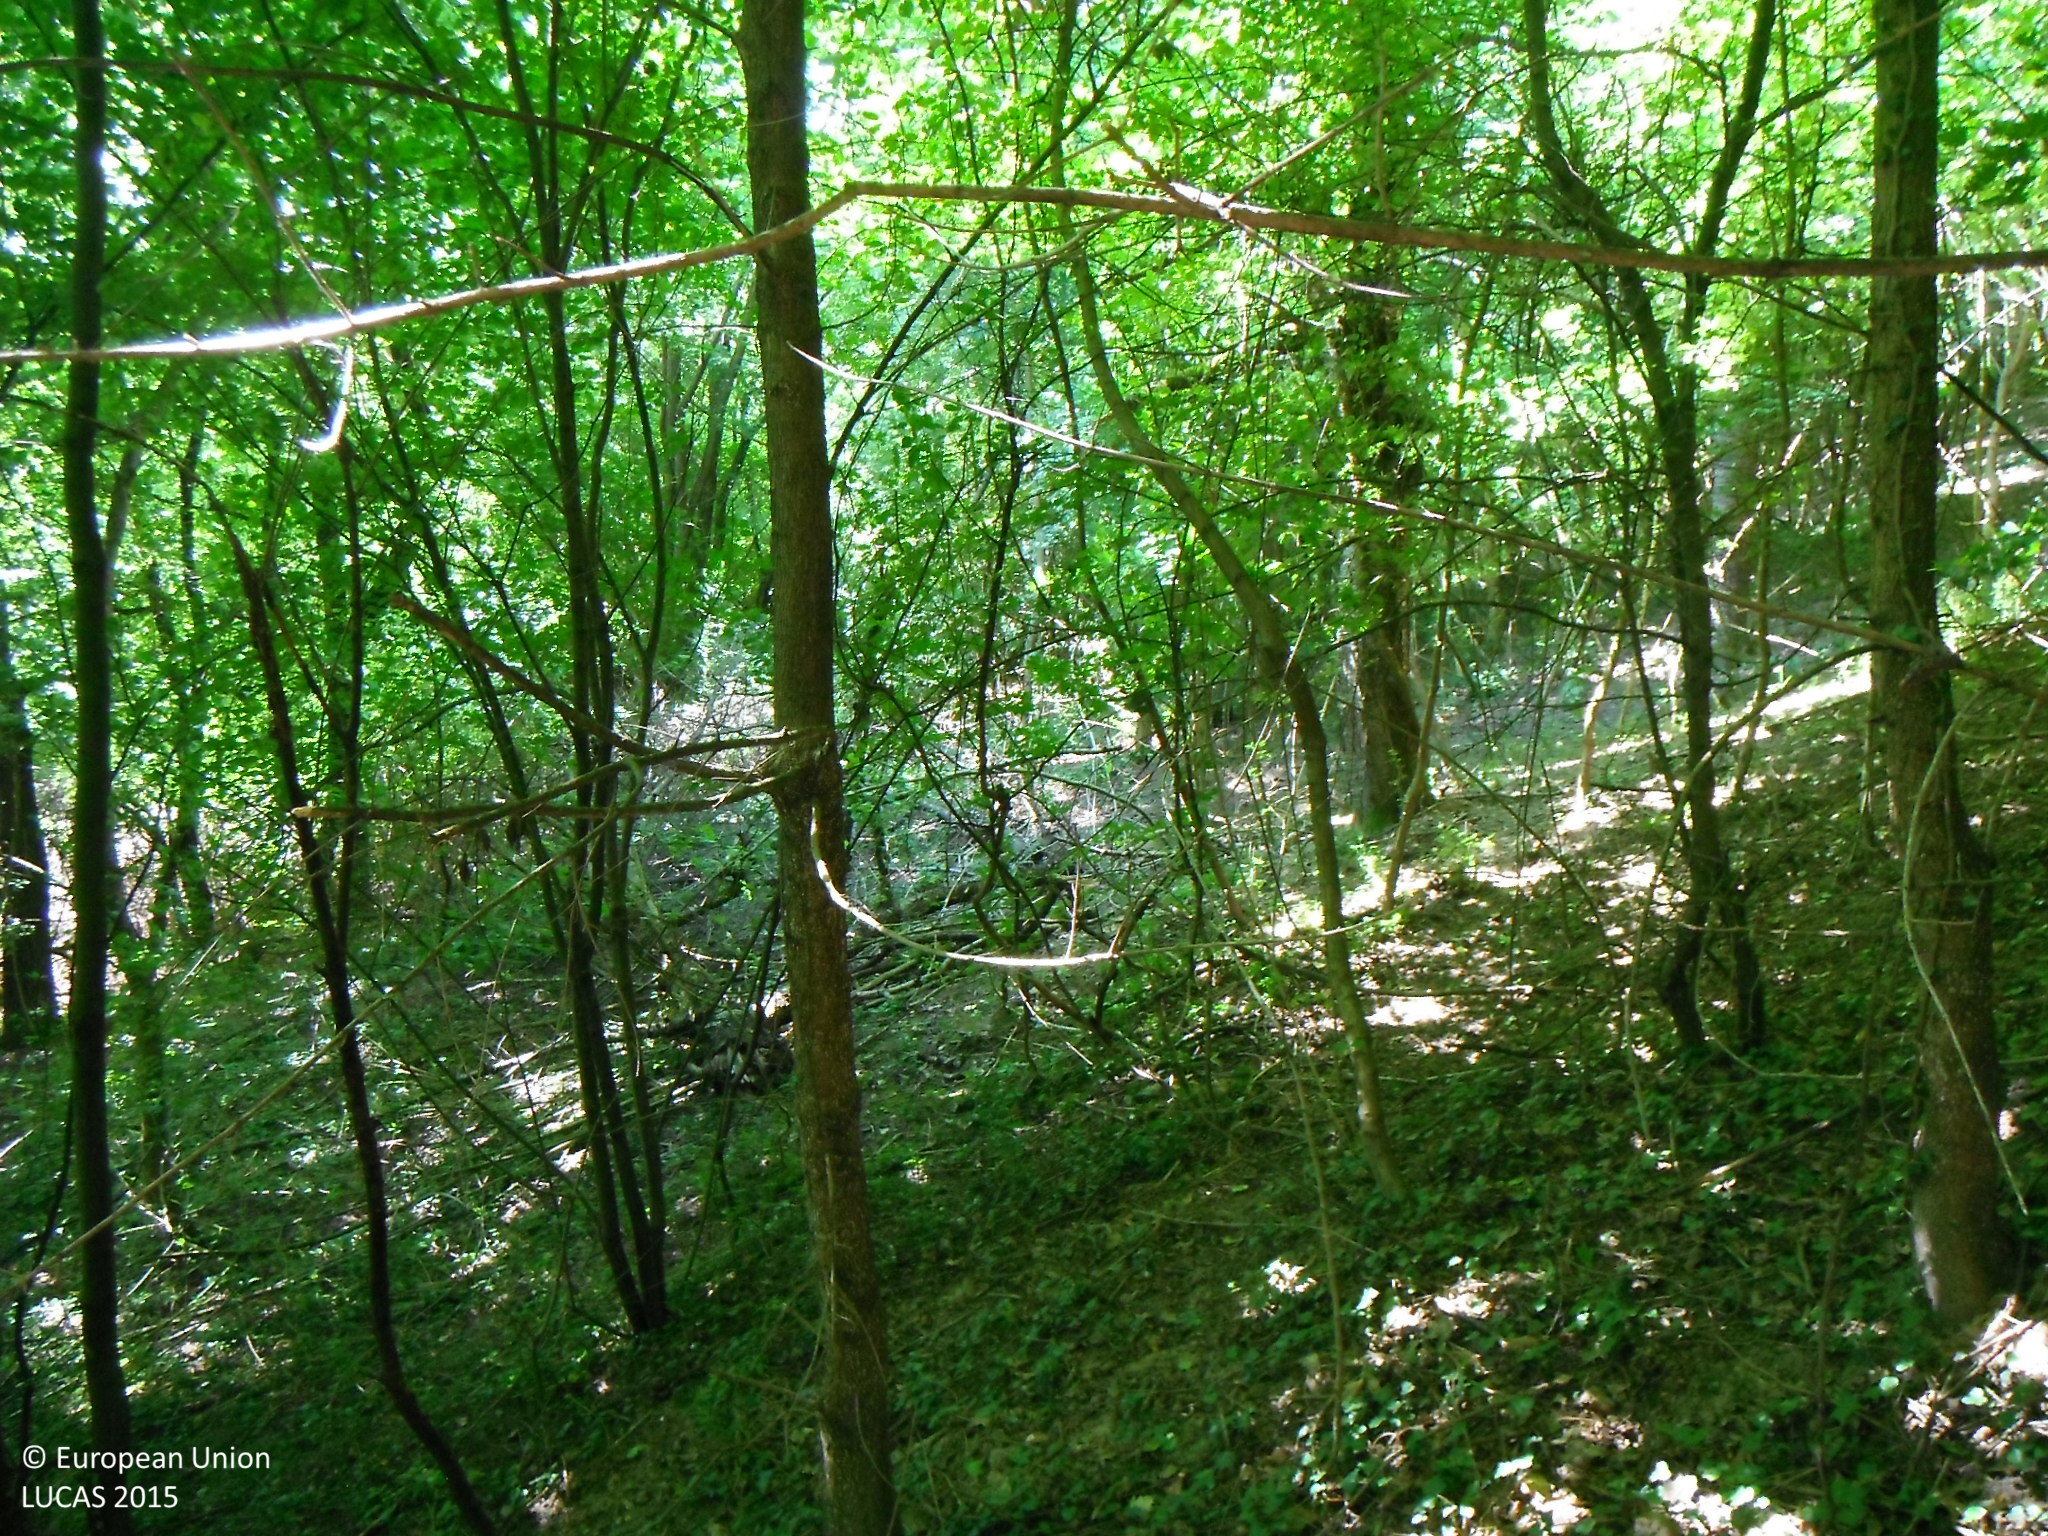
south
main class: Woodland
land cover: Broadleaved woodland
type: mesophytic deciduous forest
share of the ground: > 75 %
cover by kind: broadleaved forest trees 95 %, herbaceous plants 5 %
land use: Forestry
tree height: > 5 m
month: June
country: SK
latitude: 48.5107
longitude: 18.7225
